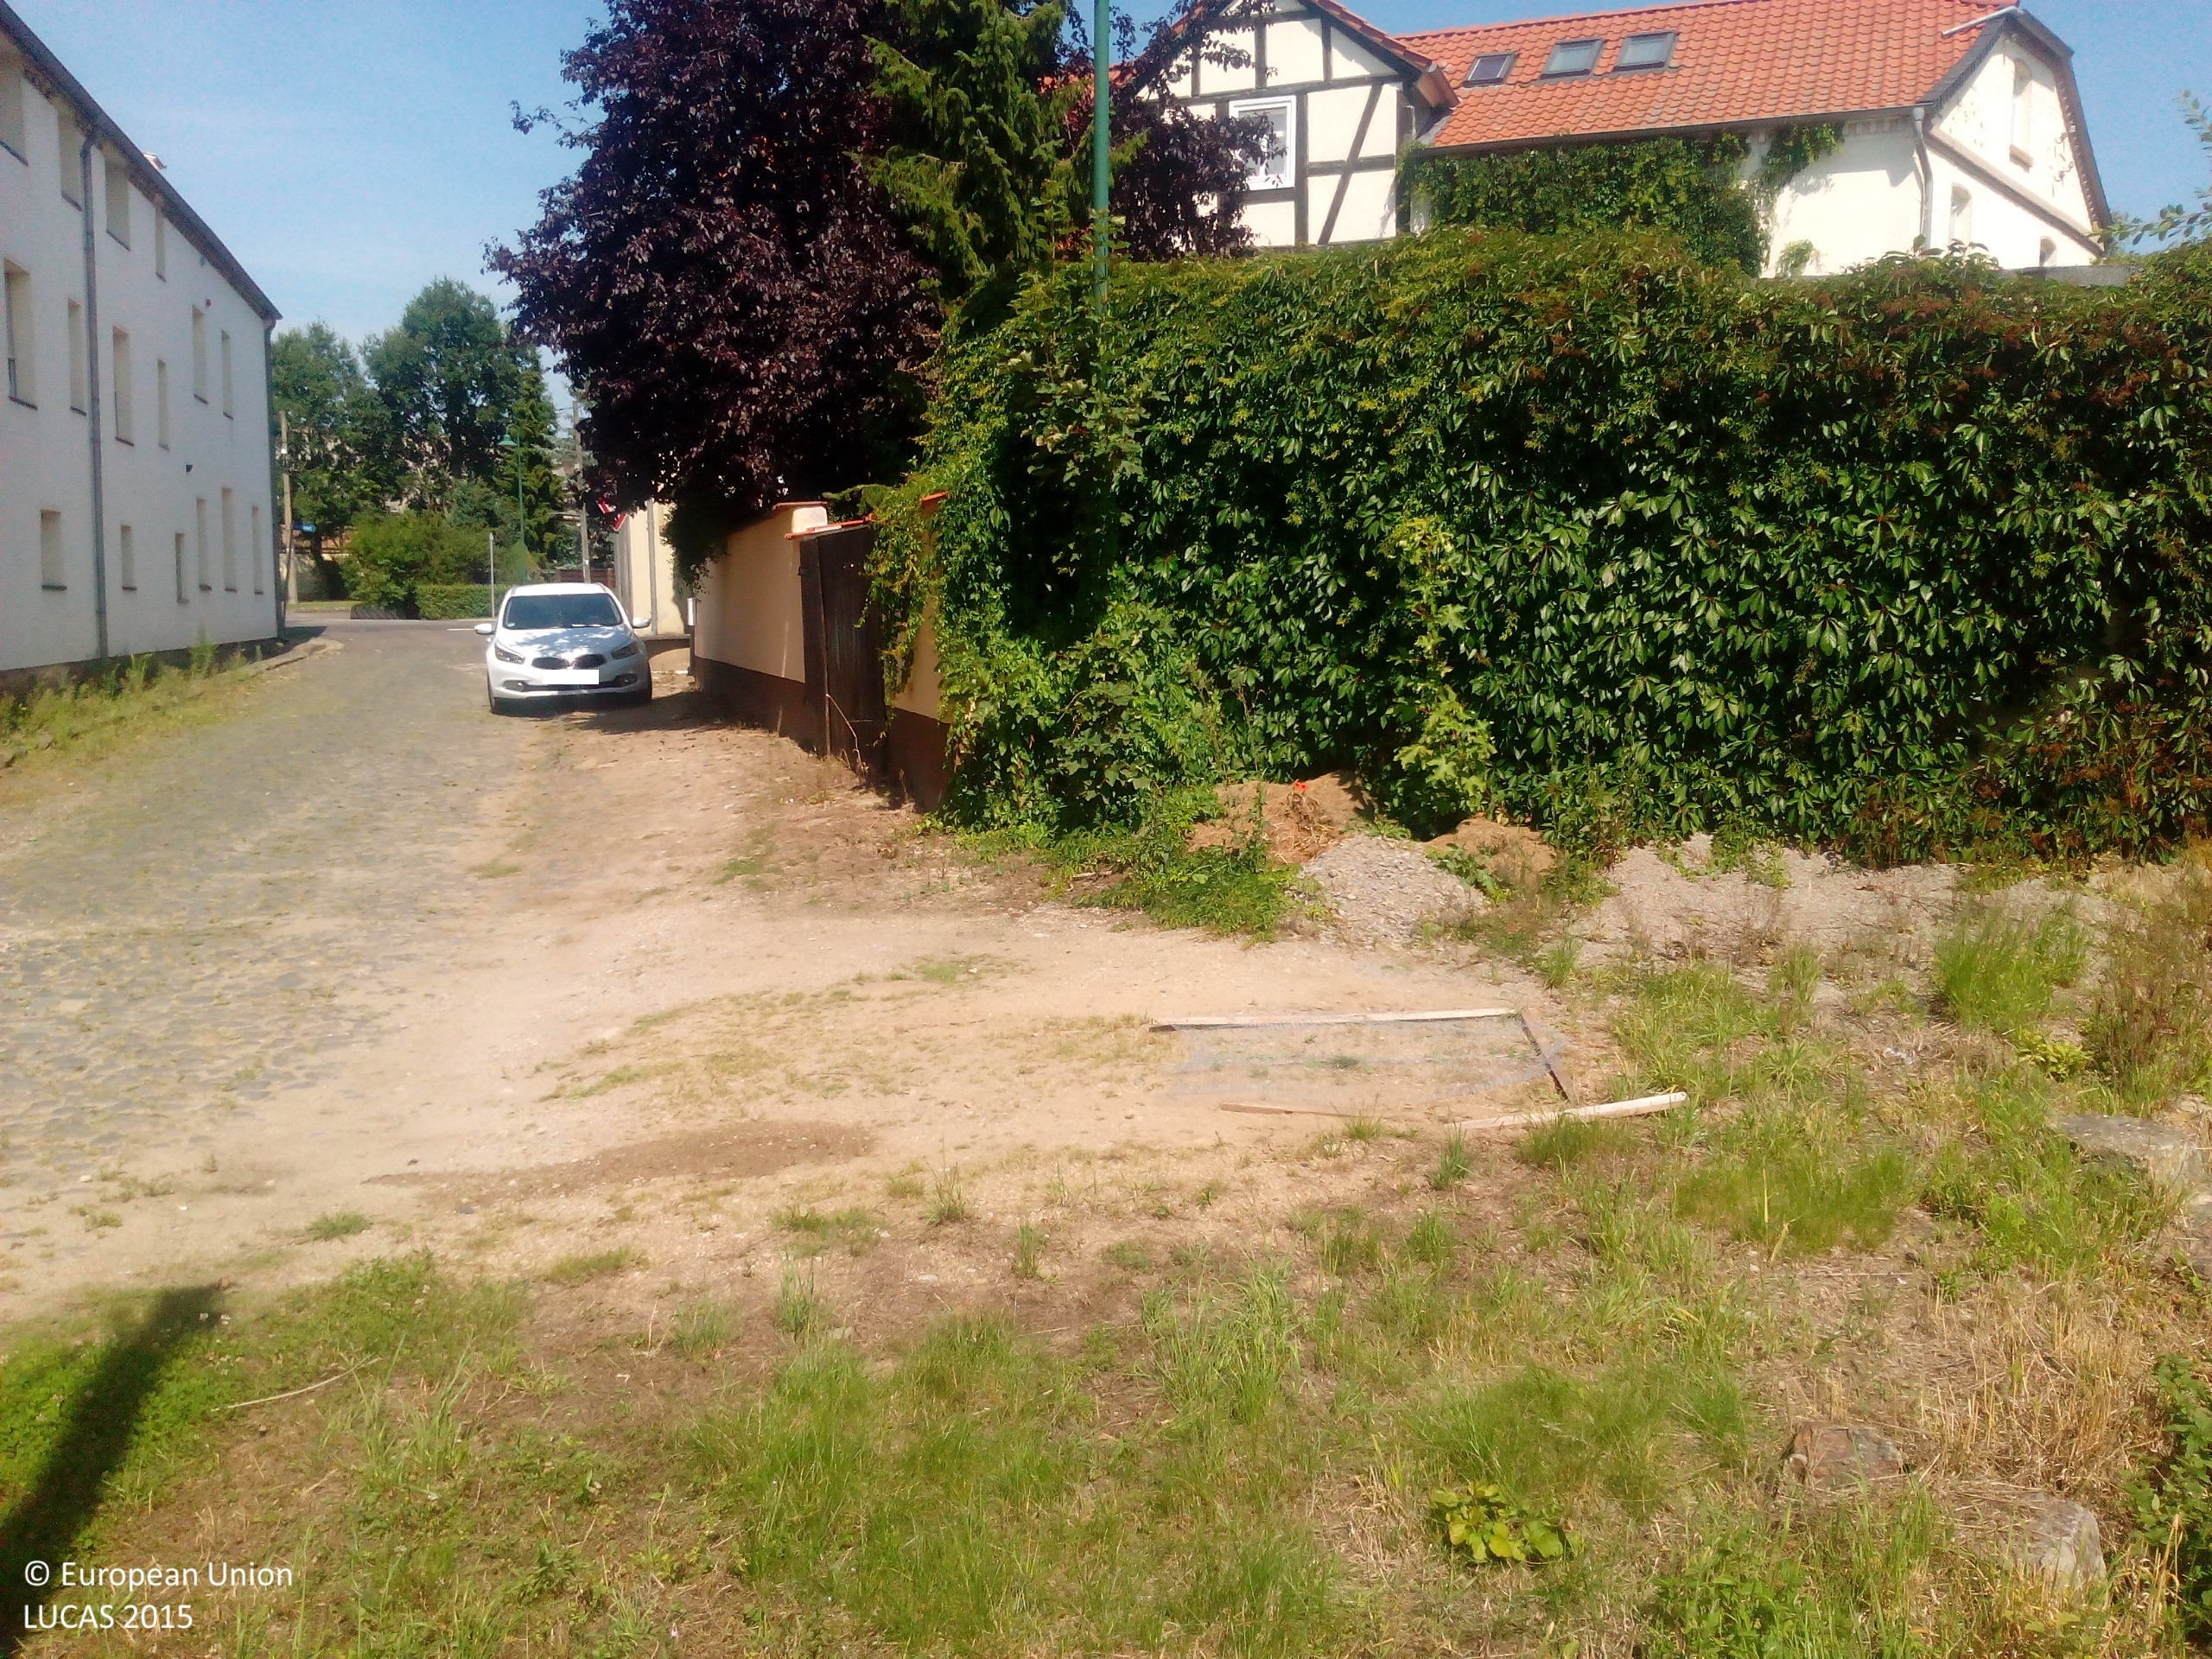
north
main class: Grassland
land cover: Grassland with sparse tree/shrub cover
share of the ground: > 75 %
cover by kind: herbaceous plants 95 %, broadleaved forest trees 5 %
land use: Residential
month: August
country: DE
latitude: 52.0845
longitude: 11.1233
